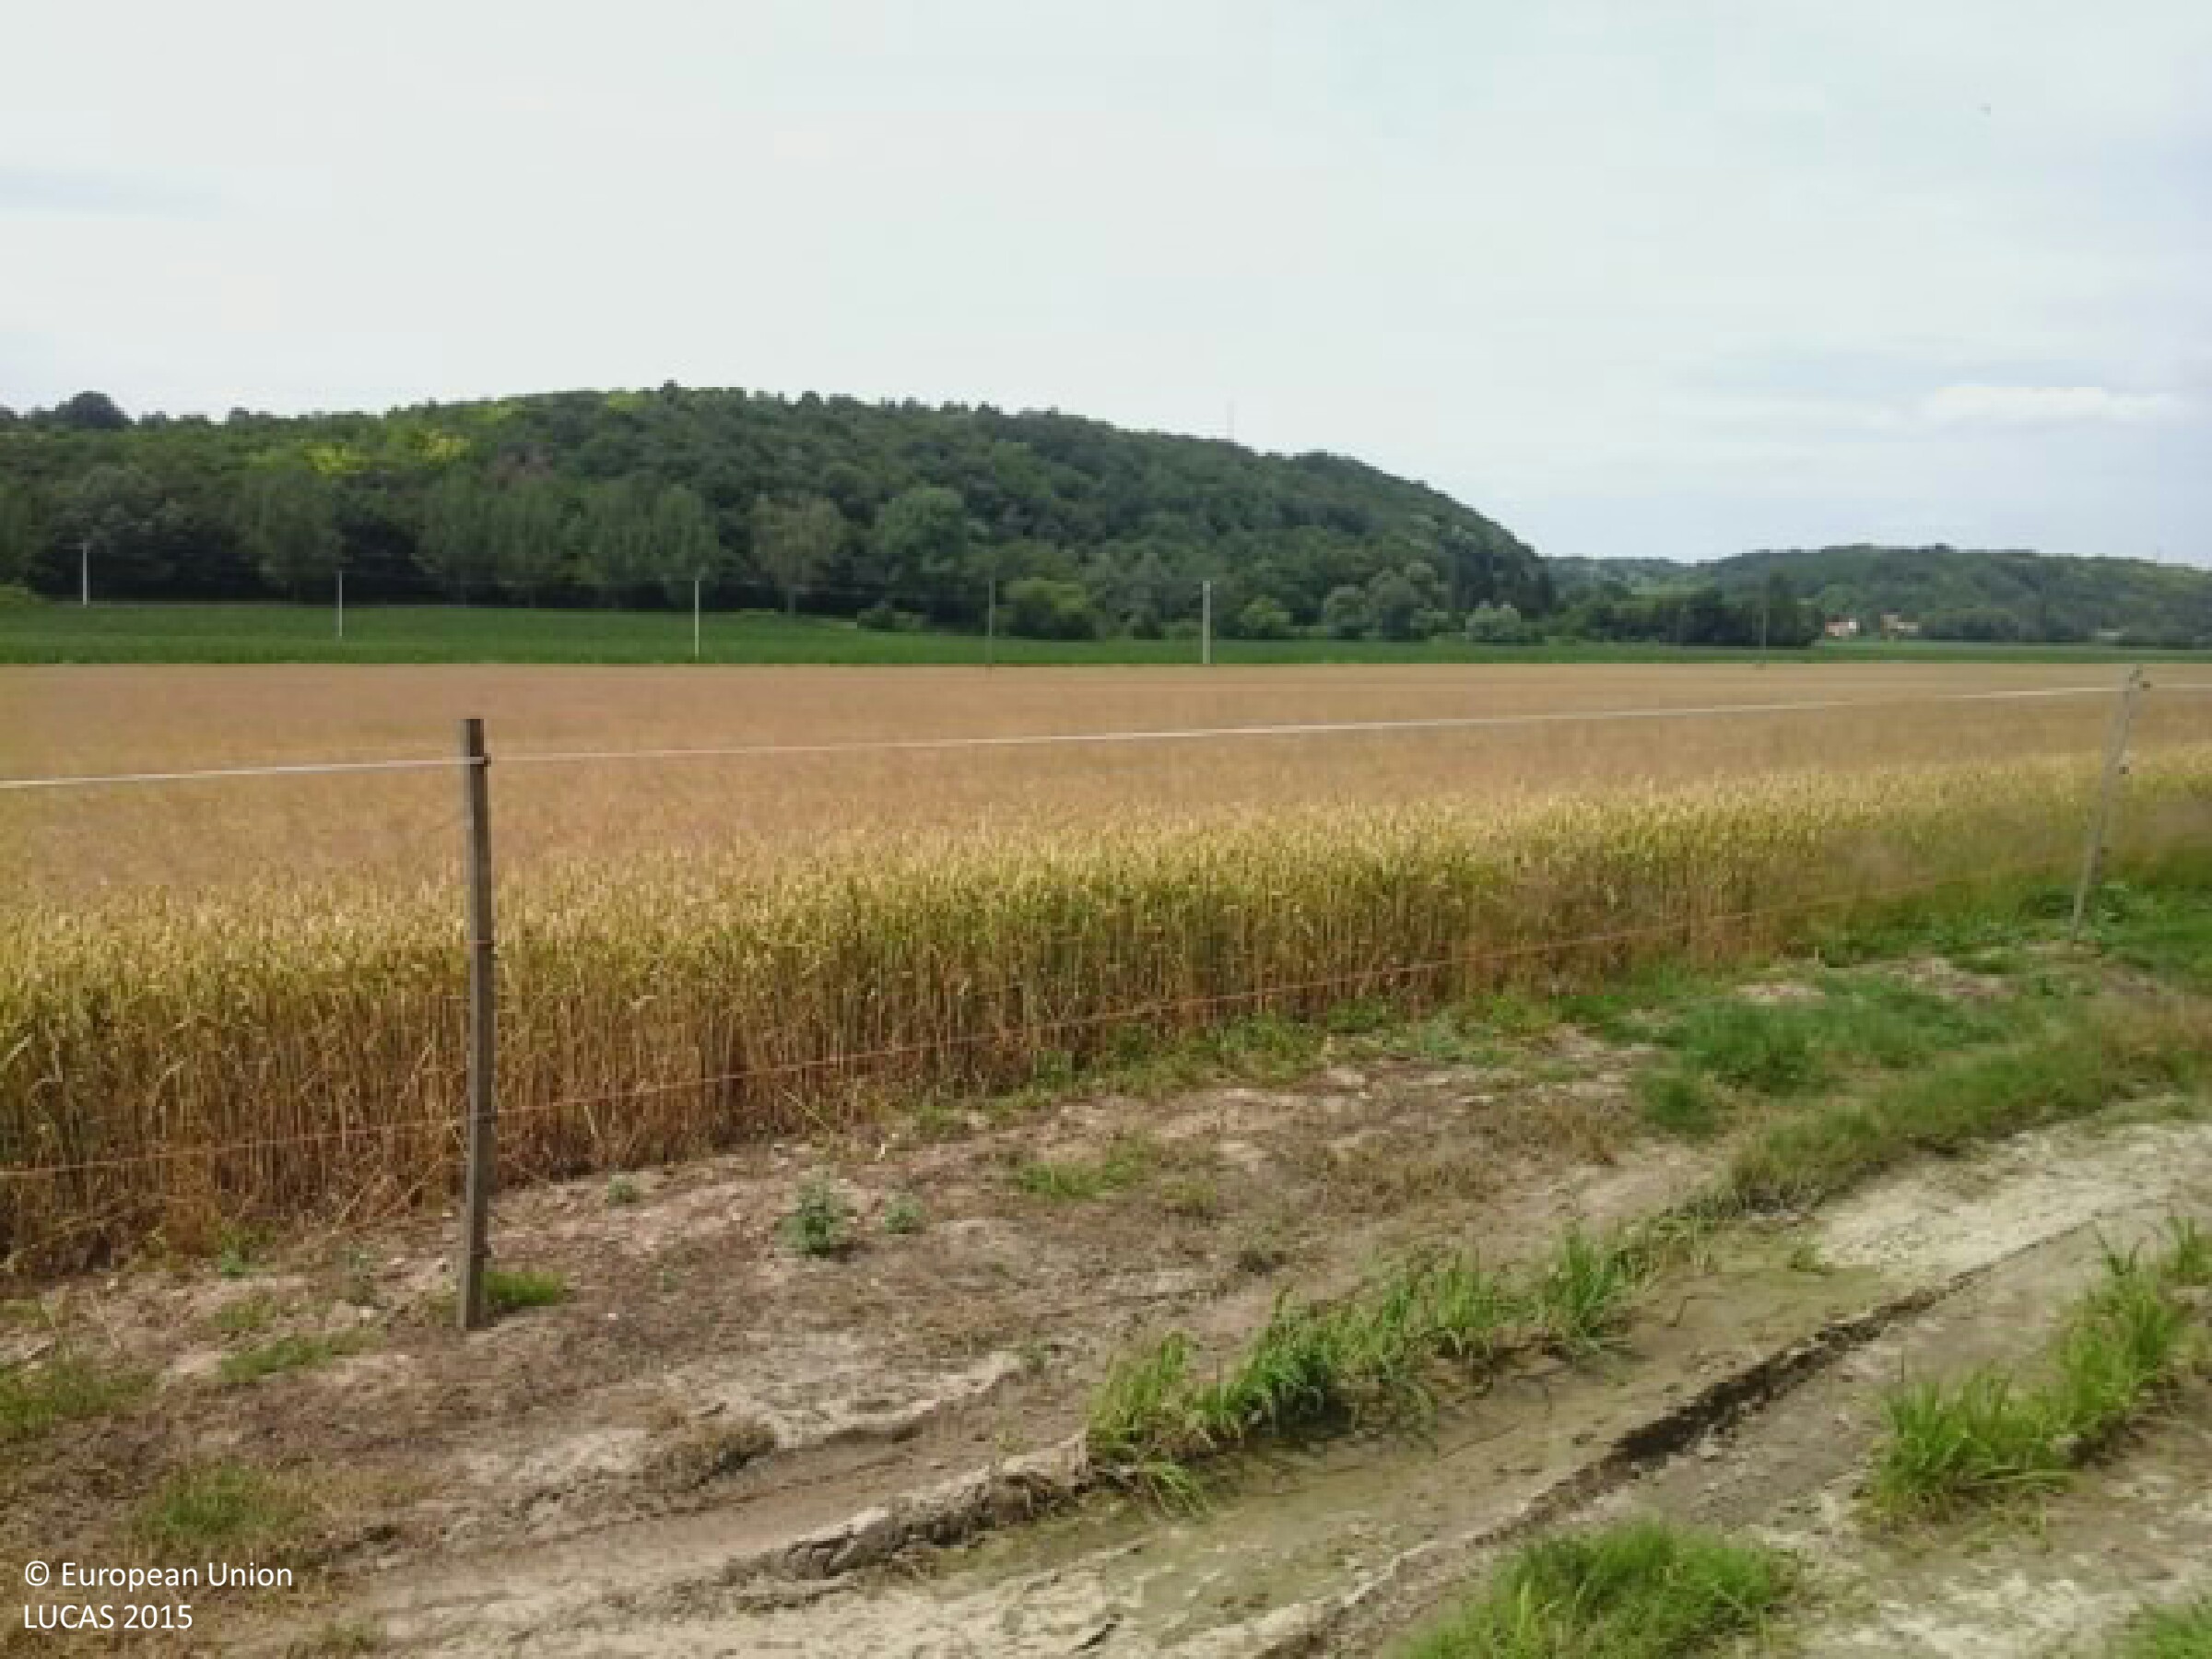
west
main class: Cropland
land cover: Common wheat
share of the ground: < 10 %
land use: Agriculture (excluding fallow land and kitchen gardens)
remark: Harvested field
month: June
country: HU
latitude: 46.2950
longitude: 17.8859
